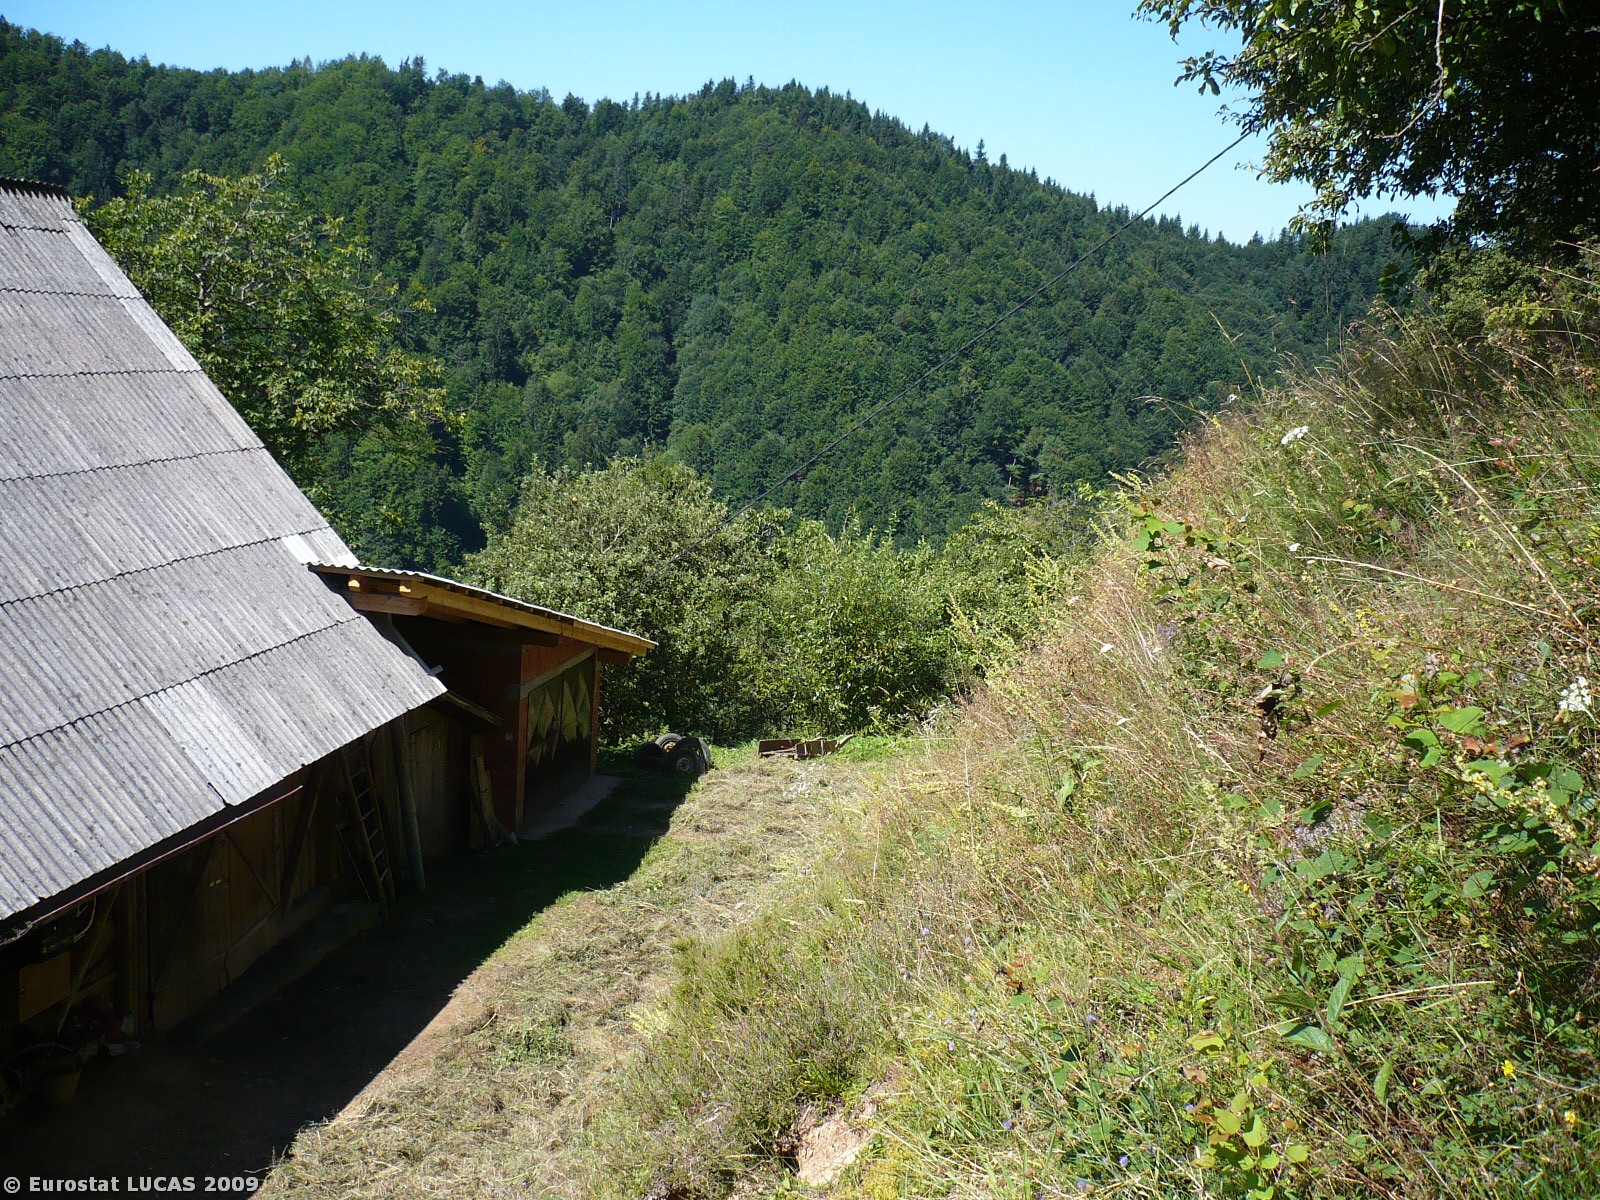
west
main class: Shrubland
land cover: Shrubland with sparse tree cover
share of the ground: > 75 %
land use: Unused
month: July
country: SI
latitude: 46.6149
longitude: 15.3393
